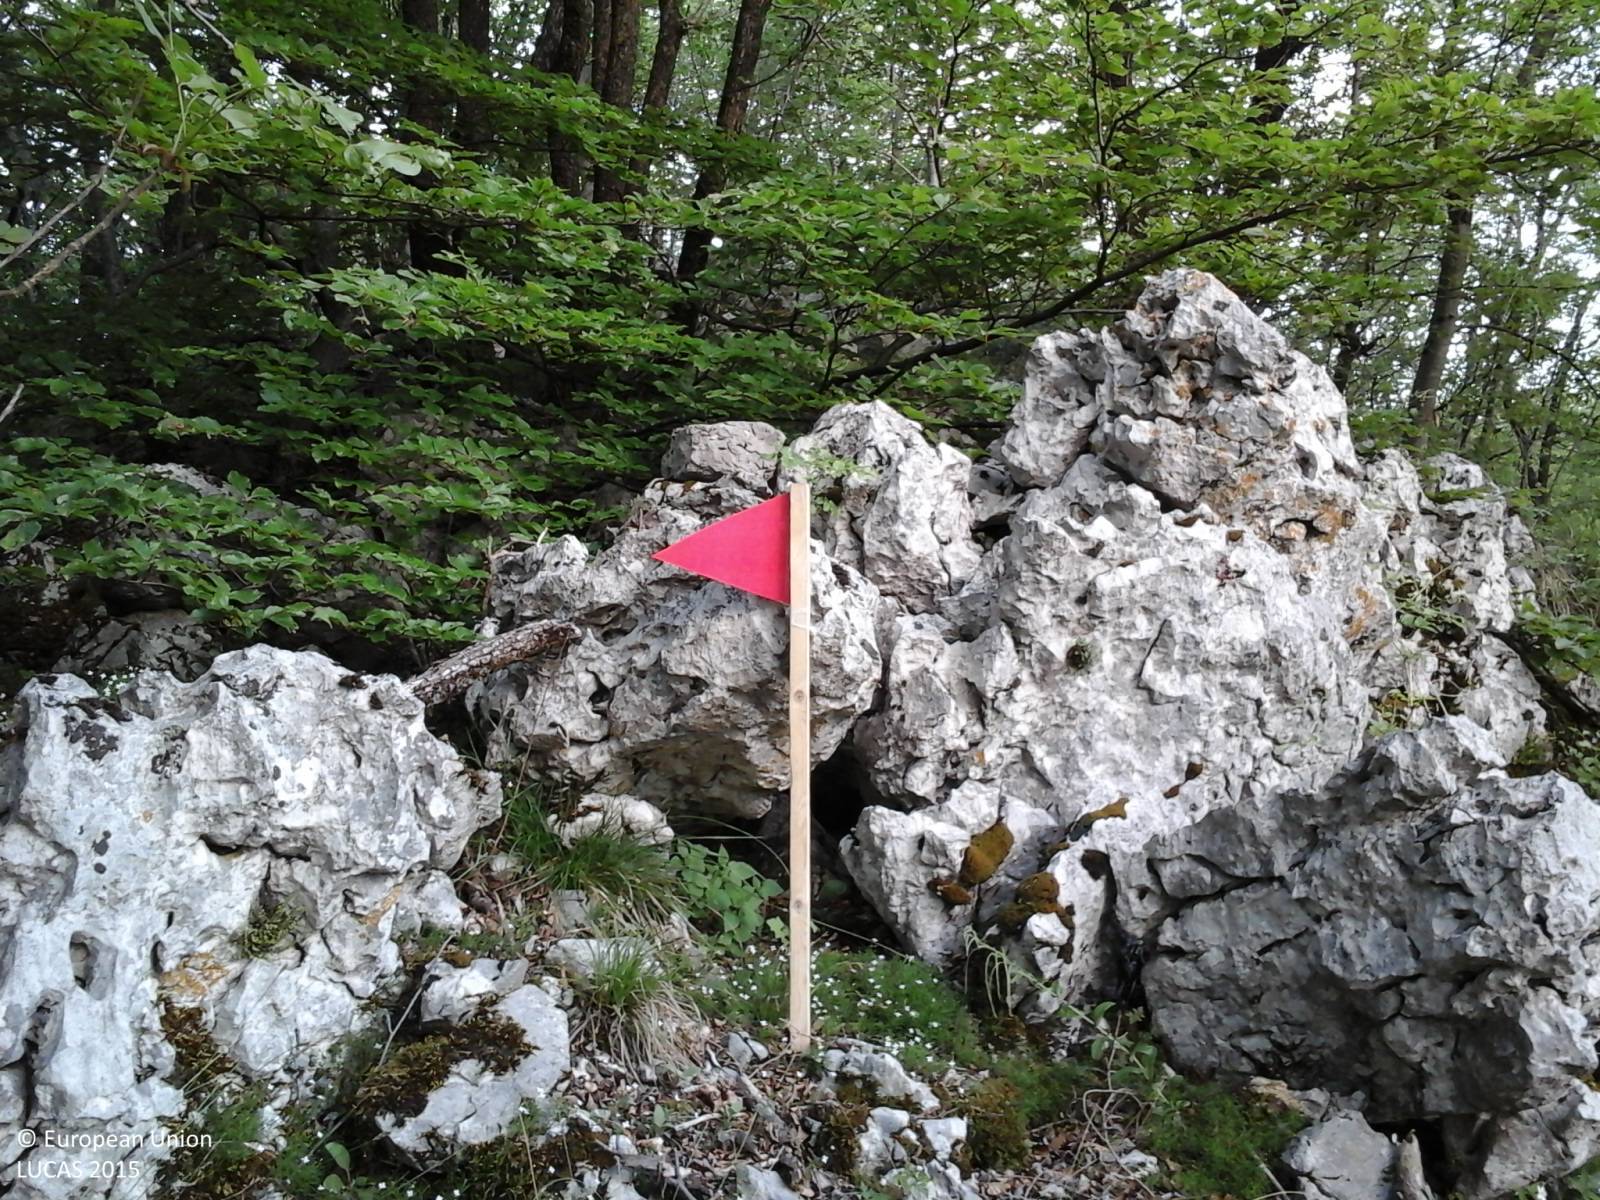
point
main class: Woodland
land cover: Broadleaved woodland
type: beech forest
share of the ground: > 75 %
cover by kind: broadleaved forest trees 70 %, shrubs 15 %, consolidated bare surface 10 %, herbaceous plants 5 %
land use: Forestry
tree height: > 5 m
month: May
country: IT
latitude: 46.2373
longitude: 12.9924
